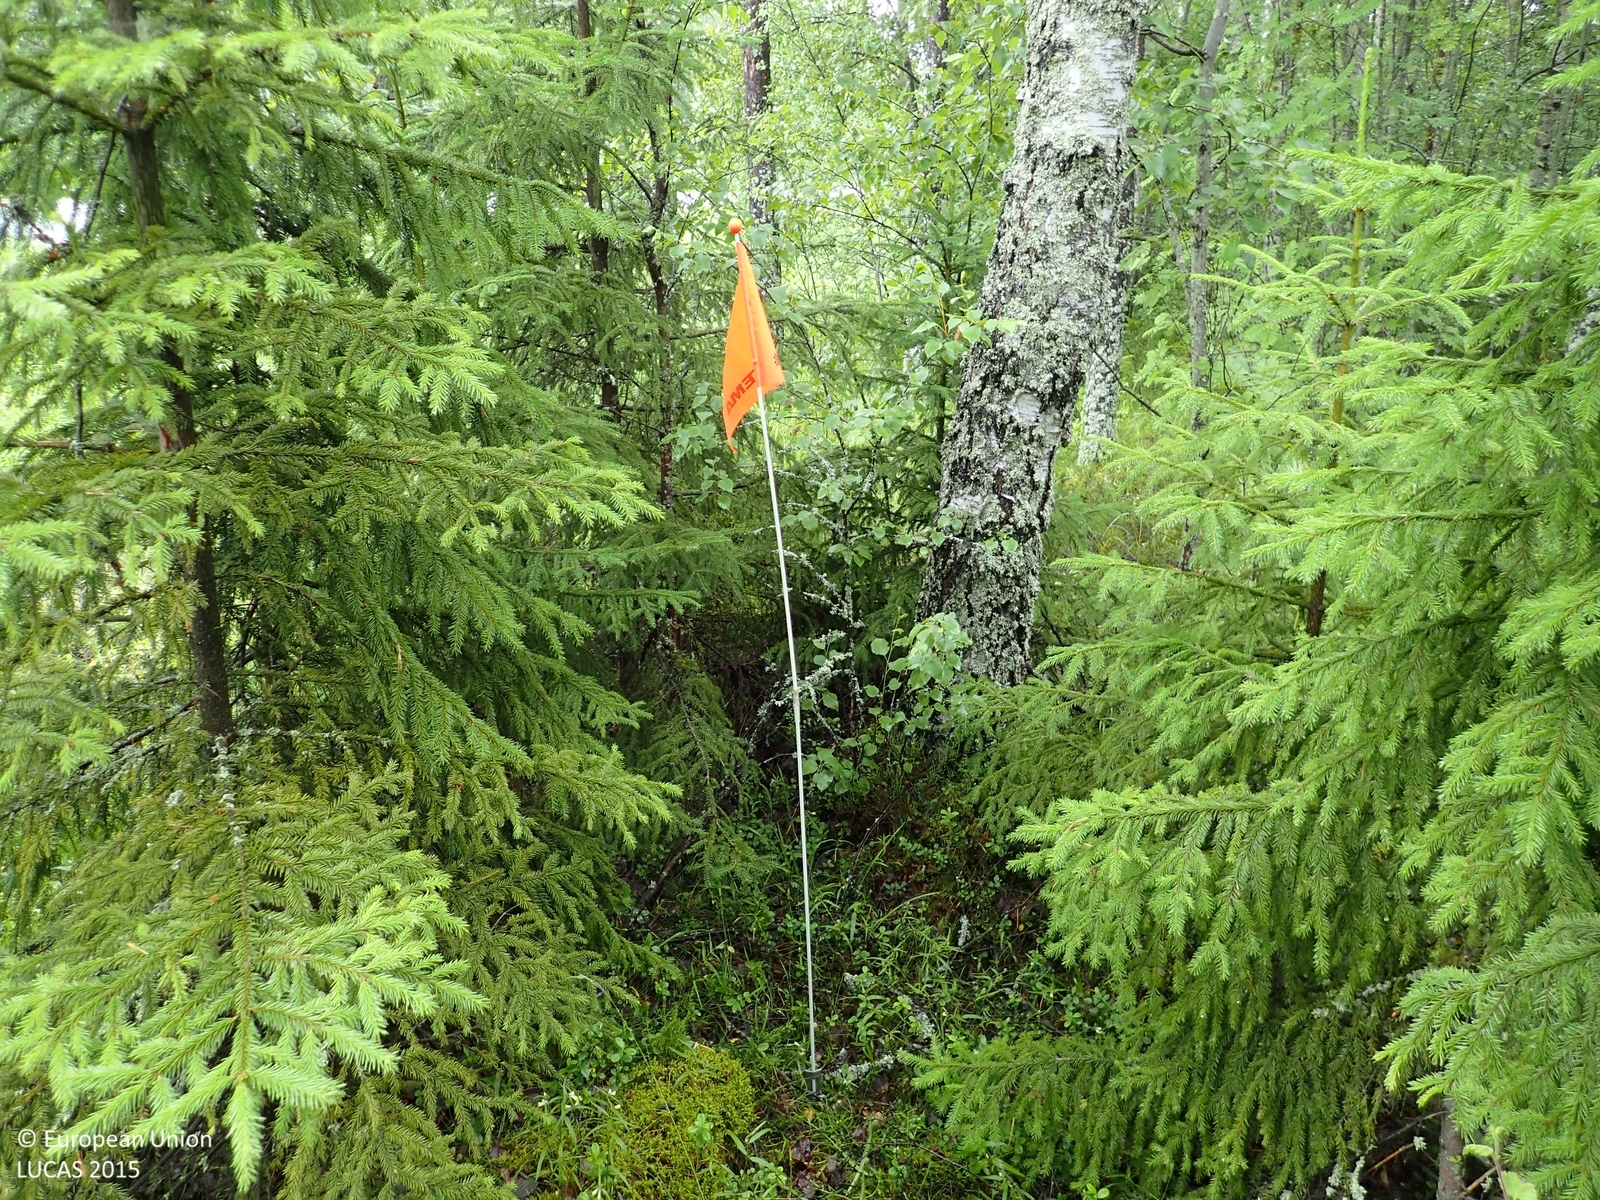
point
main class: Woodland
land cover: Pine dominated mixed woodland
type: boreal forest
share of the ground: 50 - 75 %
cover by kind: broadleaved forest trees 40 %, coniferous forest trees 20 %, shrubs 20 %, herbaceous plants 10 %, lichens and mosses 10 %
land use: Forestry
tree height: > 5 m
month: July
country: FI
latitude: 62.9826
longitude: 21.6236
